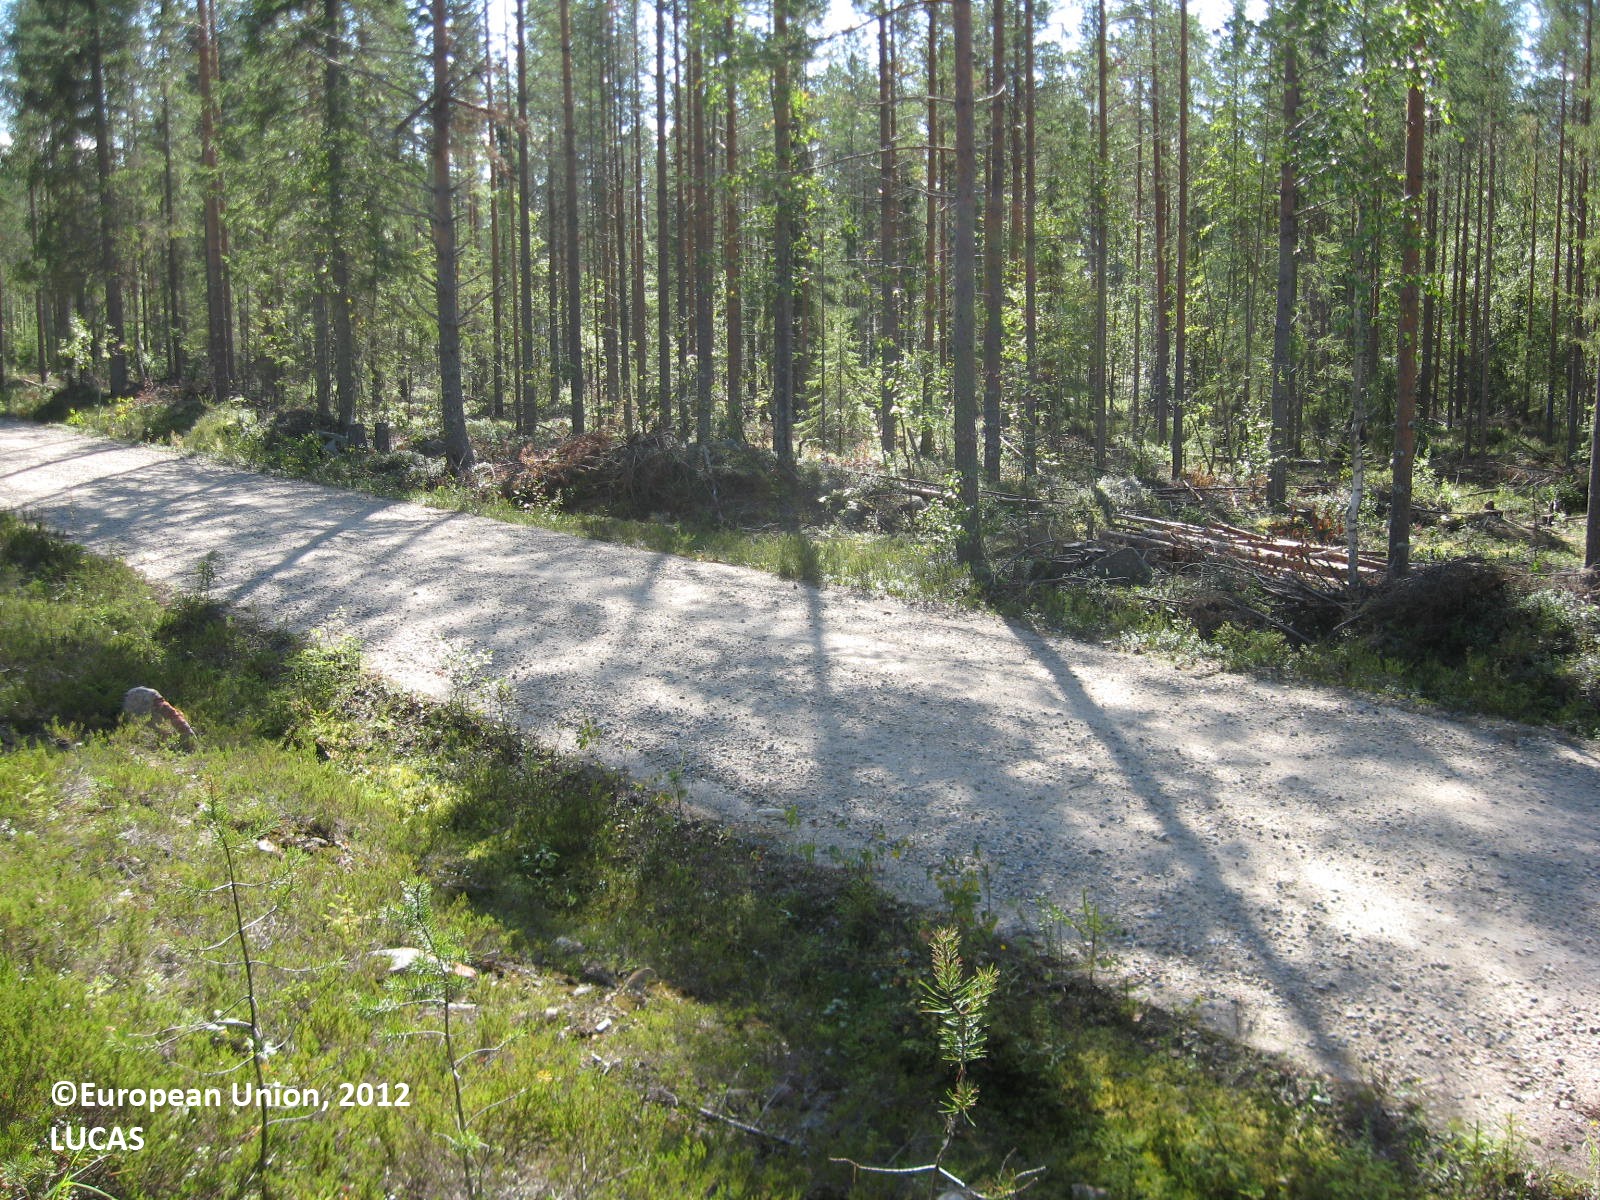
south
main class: Woodland
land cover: Pine dominated coniferous woodland
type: boreal forest
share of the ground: > 75 %
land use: Forestry
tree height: > 5 m
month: August
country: FI
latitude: 63.6475
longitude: 29.8458
